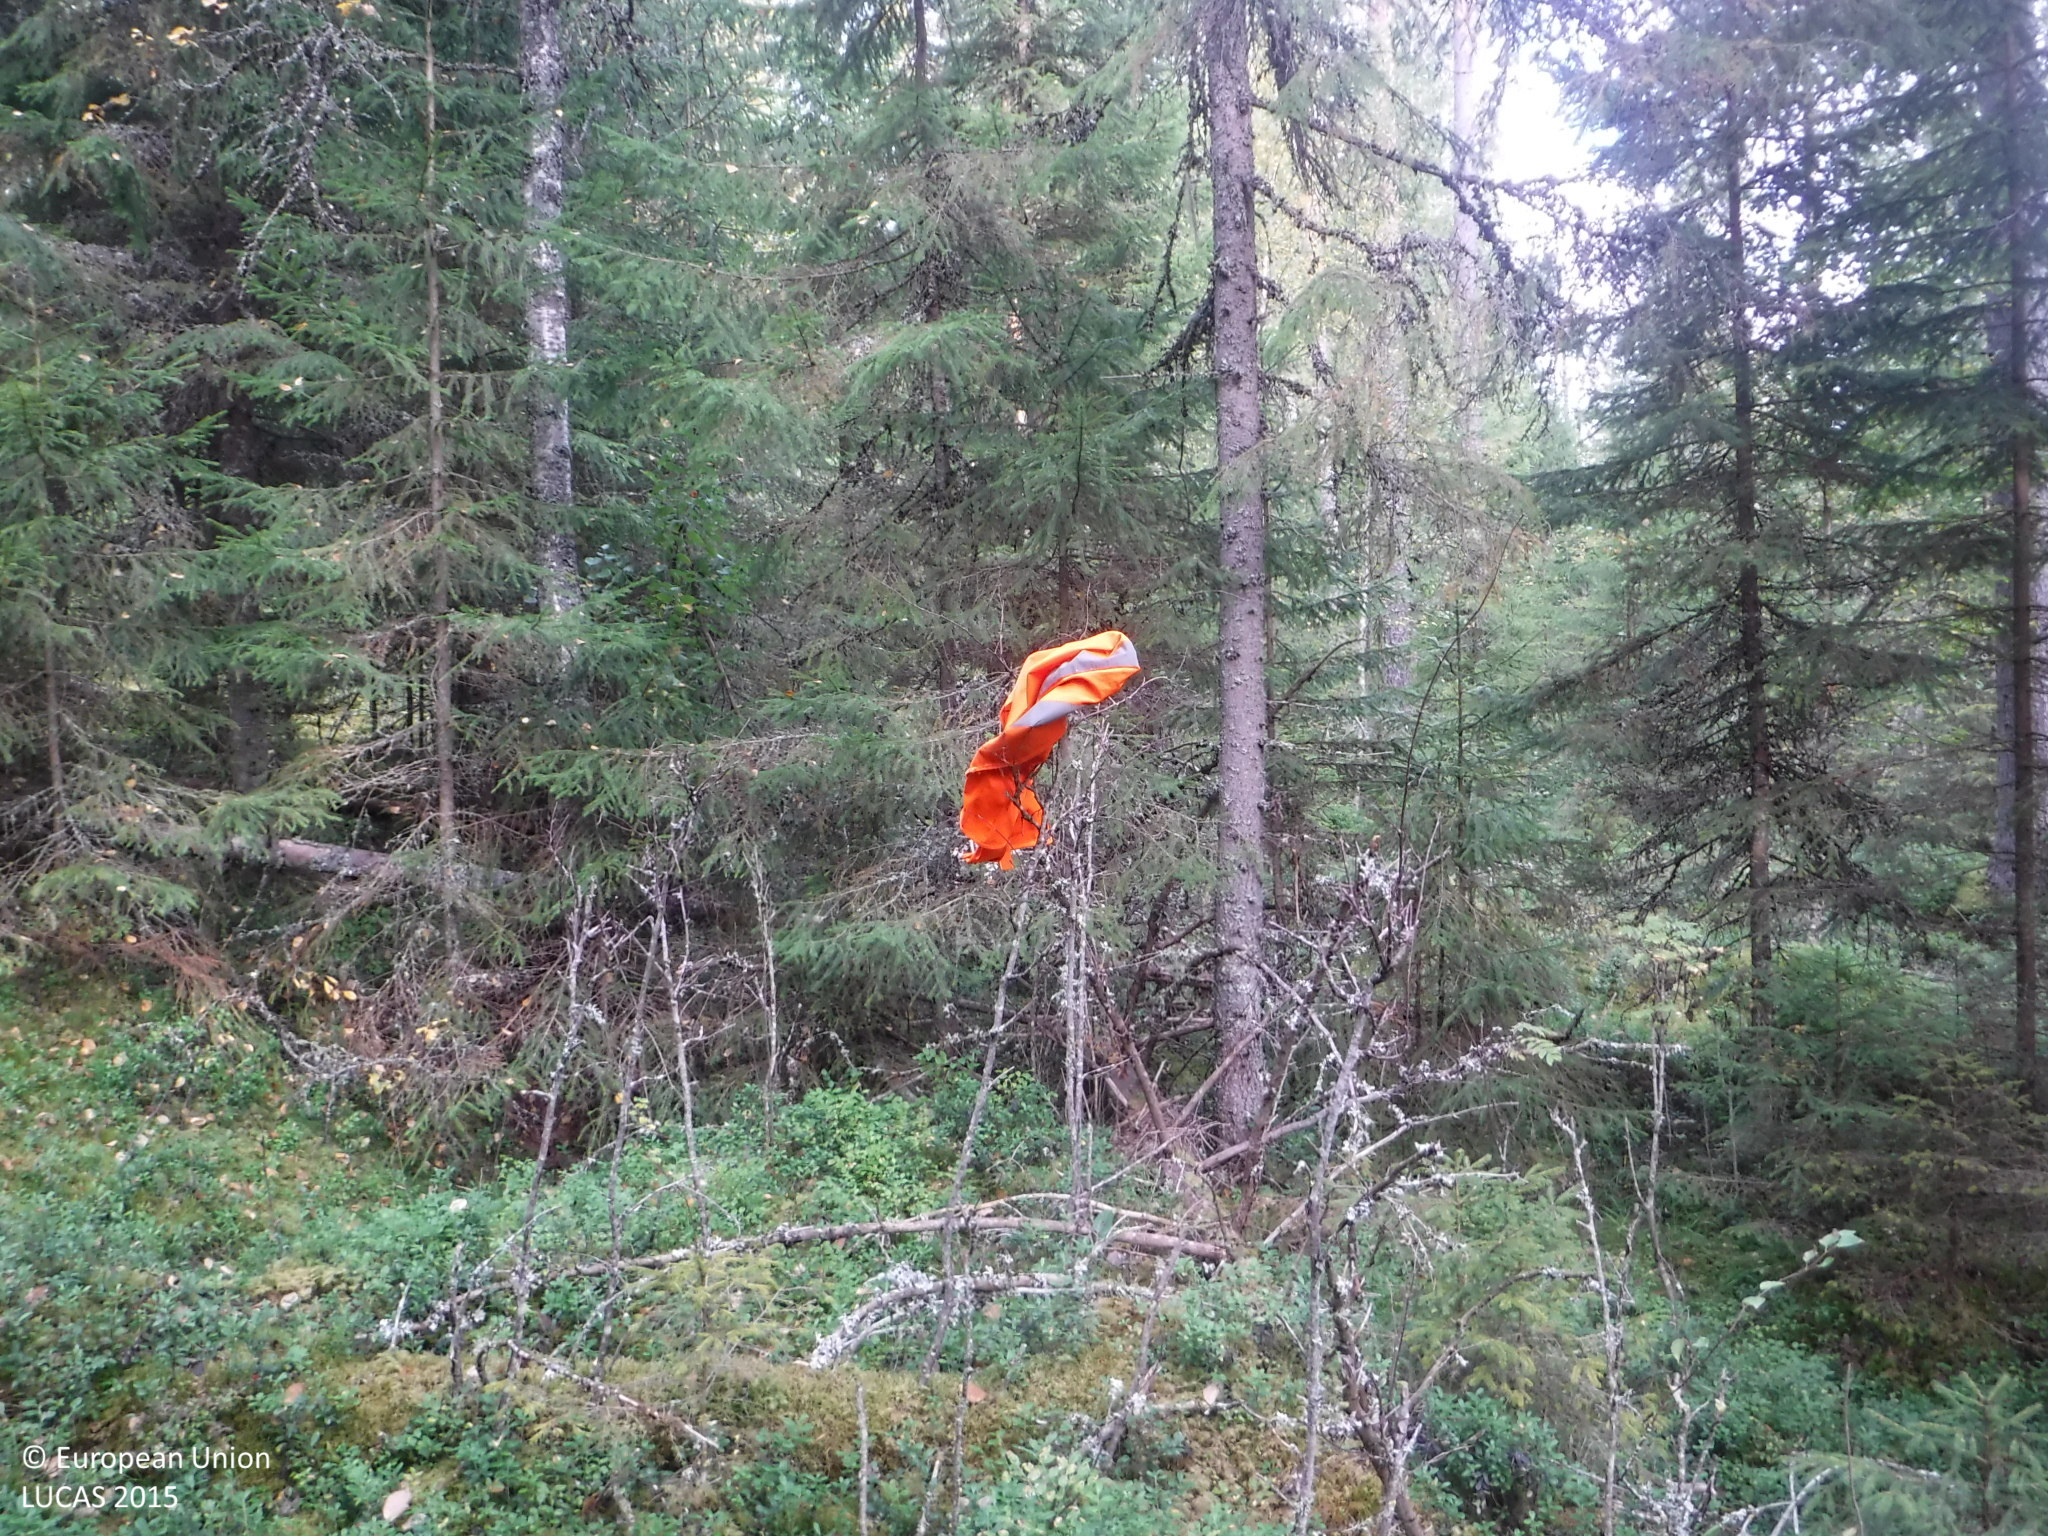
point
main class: Woodland
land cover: Spruce dominated mixed woodland
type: boreal forest
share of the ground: 50 - 75 %
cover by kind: coniferous forest trees 35 %, shrubs 25 %, lichens and mosses 25 %, broadleaved forest trees 15 %
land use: Forestry
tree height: > 5 m
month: September
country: FI
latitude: 61.7343
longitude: 22.1527
